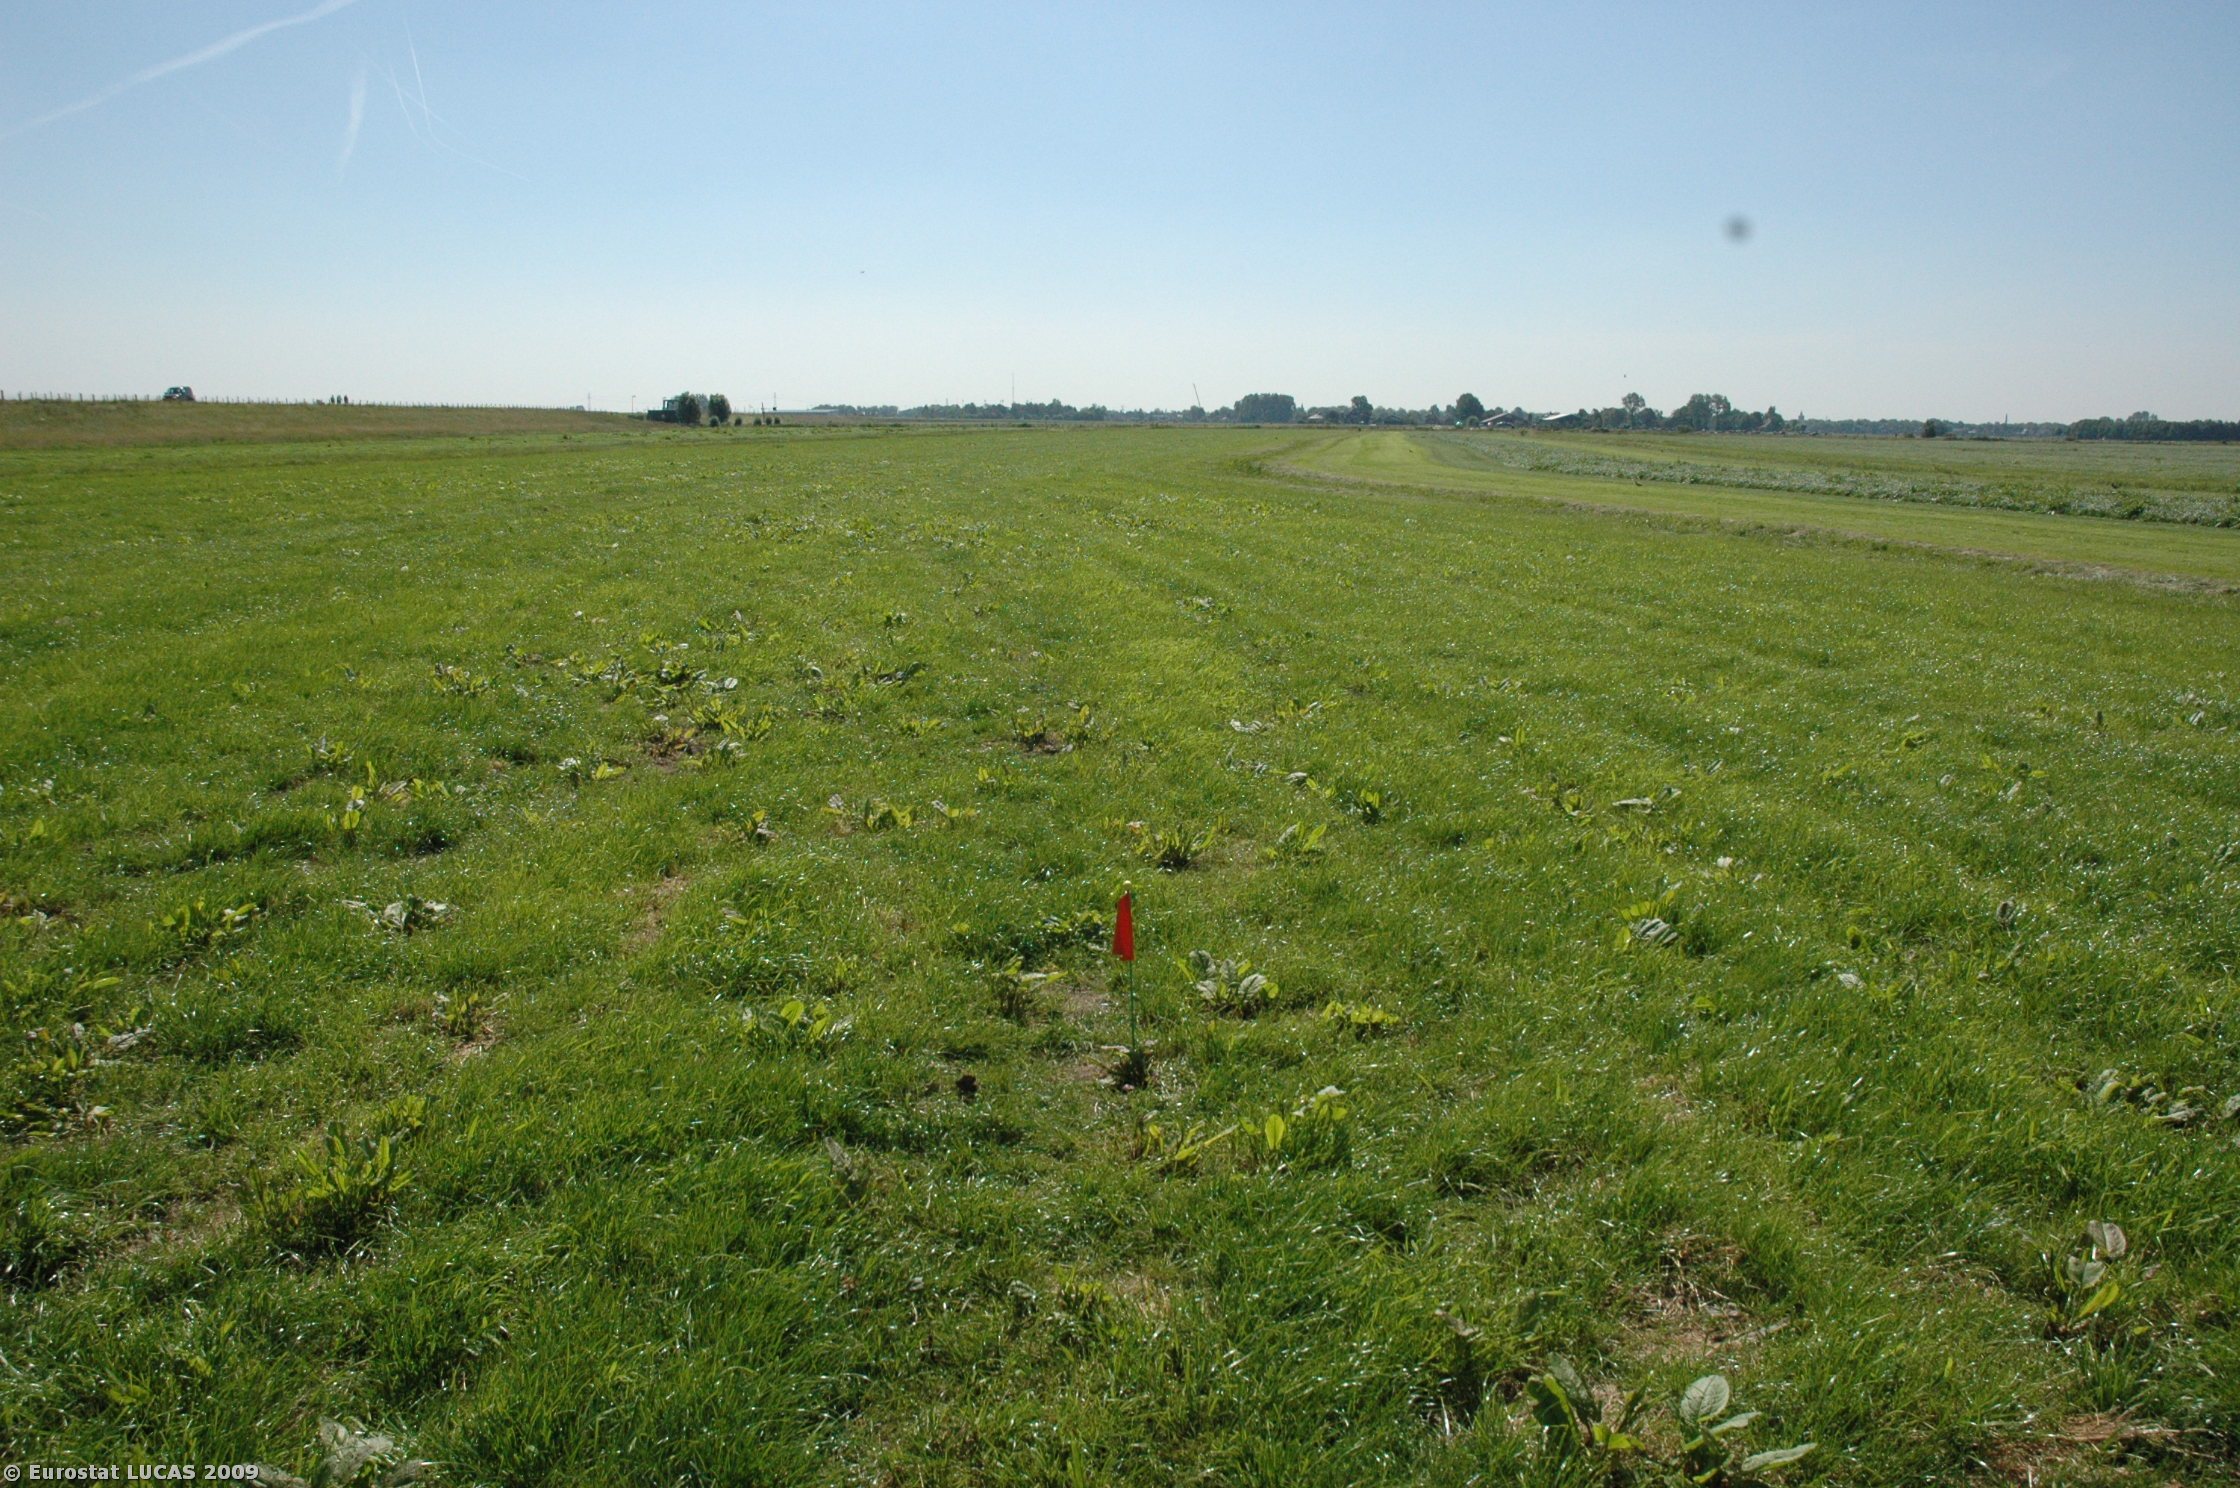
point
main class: Grassland
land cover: Grassland without tree/shrub cover
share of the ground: > 75 %
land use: Agriculture (excluding fallow land and kitchen gardens)
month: June
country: NL
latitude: 52.2685
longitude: 5.3528
